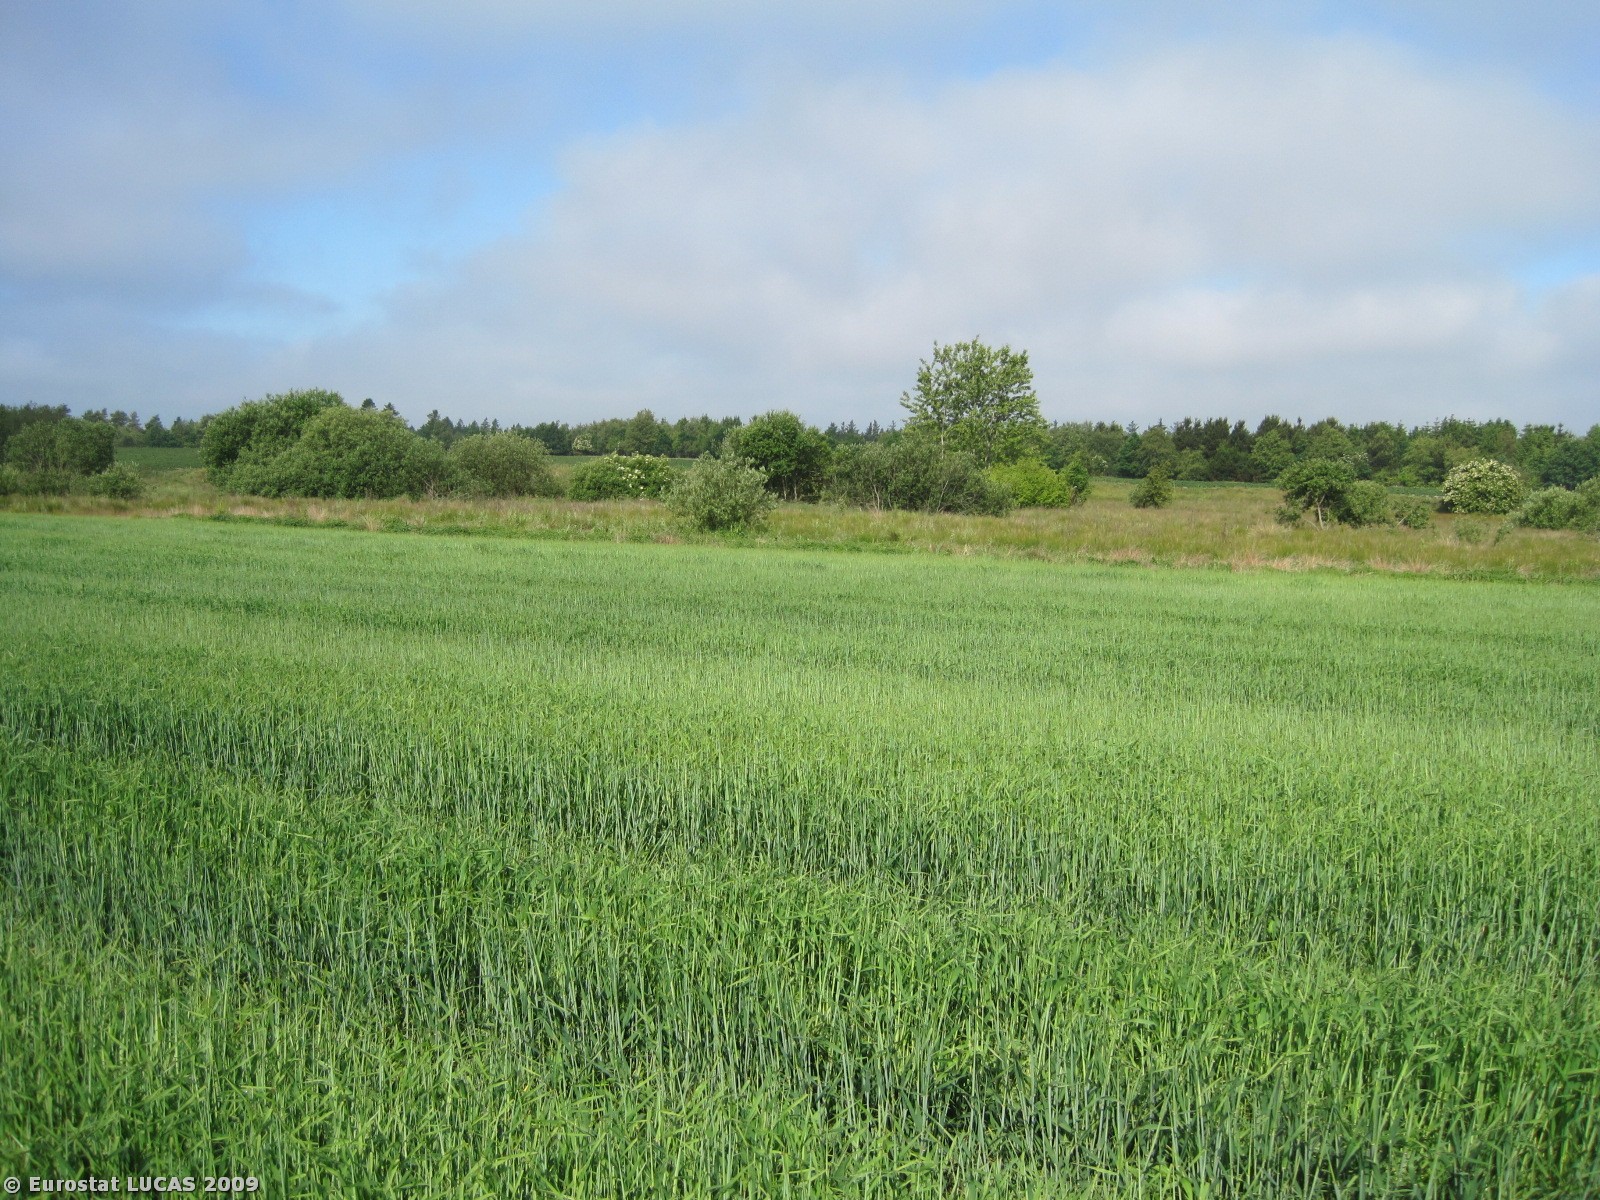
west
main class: Cropland
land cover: Barley
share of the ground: > 75 %
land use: Agriculture (excluding fallow land and kitchen gardens)
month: June
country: DK
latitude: 56.3275
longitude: 8.9824
